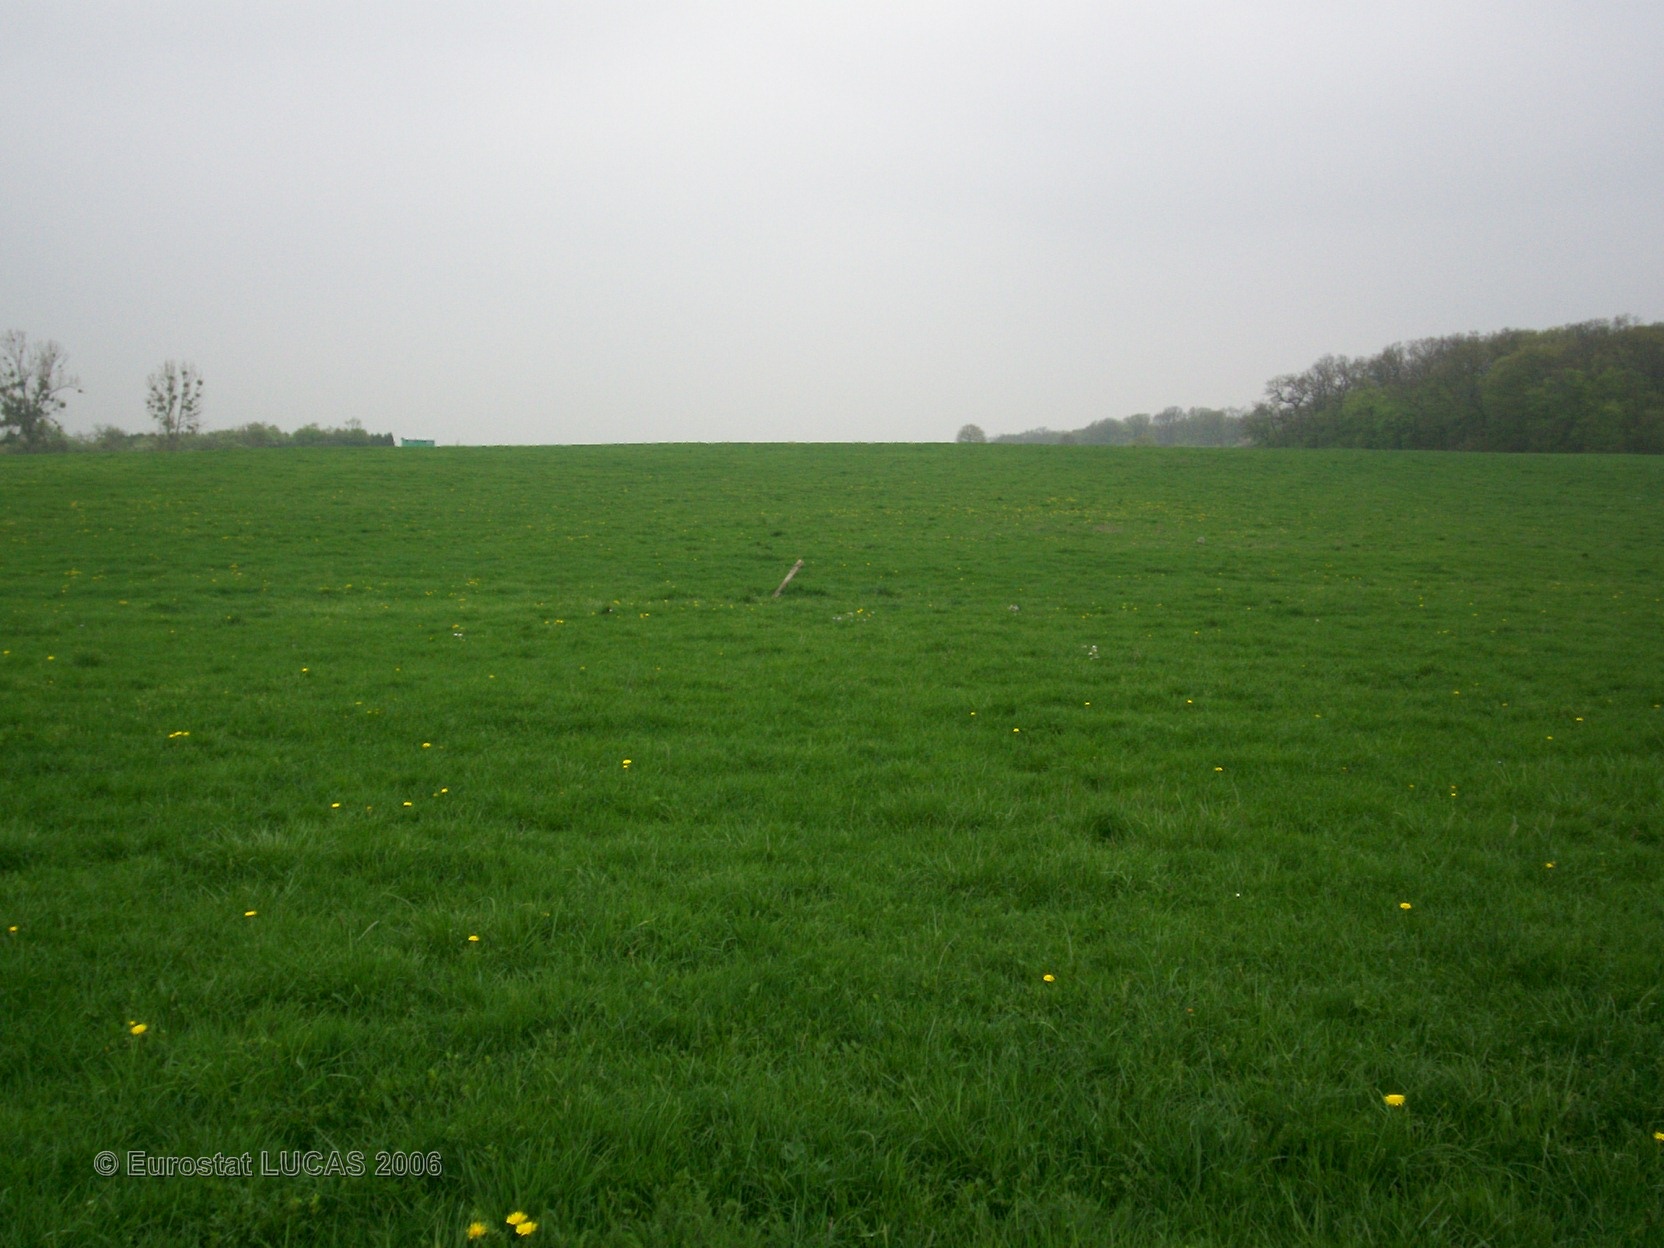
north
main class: Grassland
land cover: Grassland without tree/shrub cover
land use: Agriculture (excluding fallow land and kitchen gardens)
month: April
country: FR
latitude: 48.9152
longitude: 6.7936
